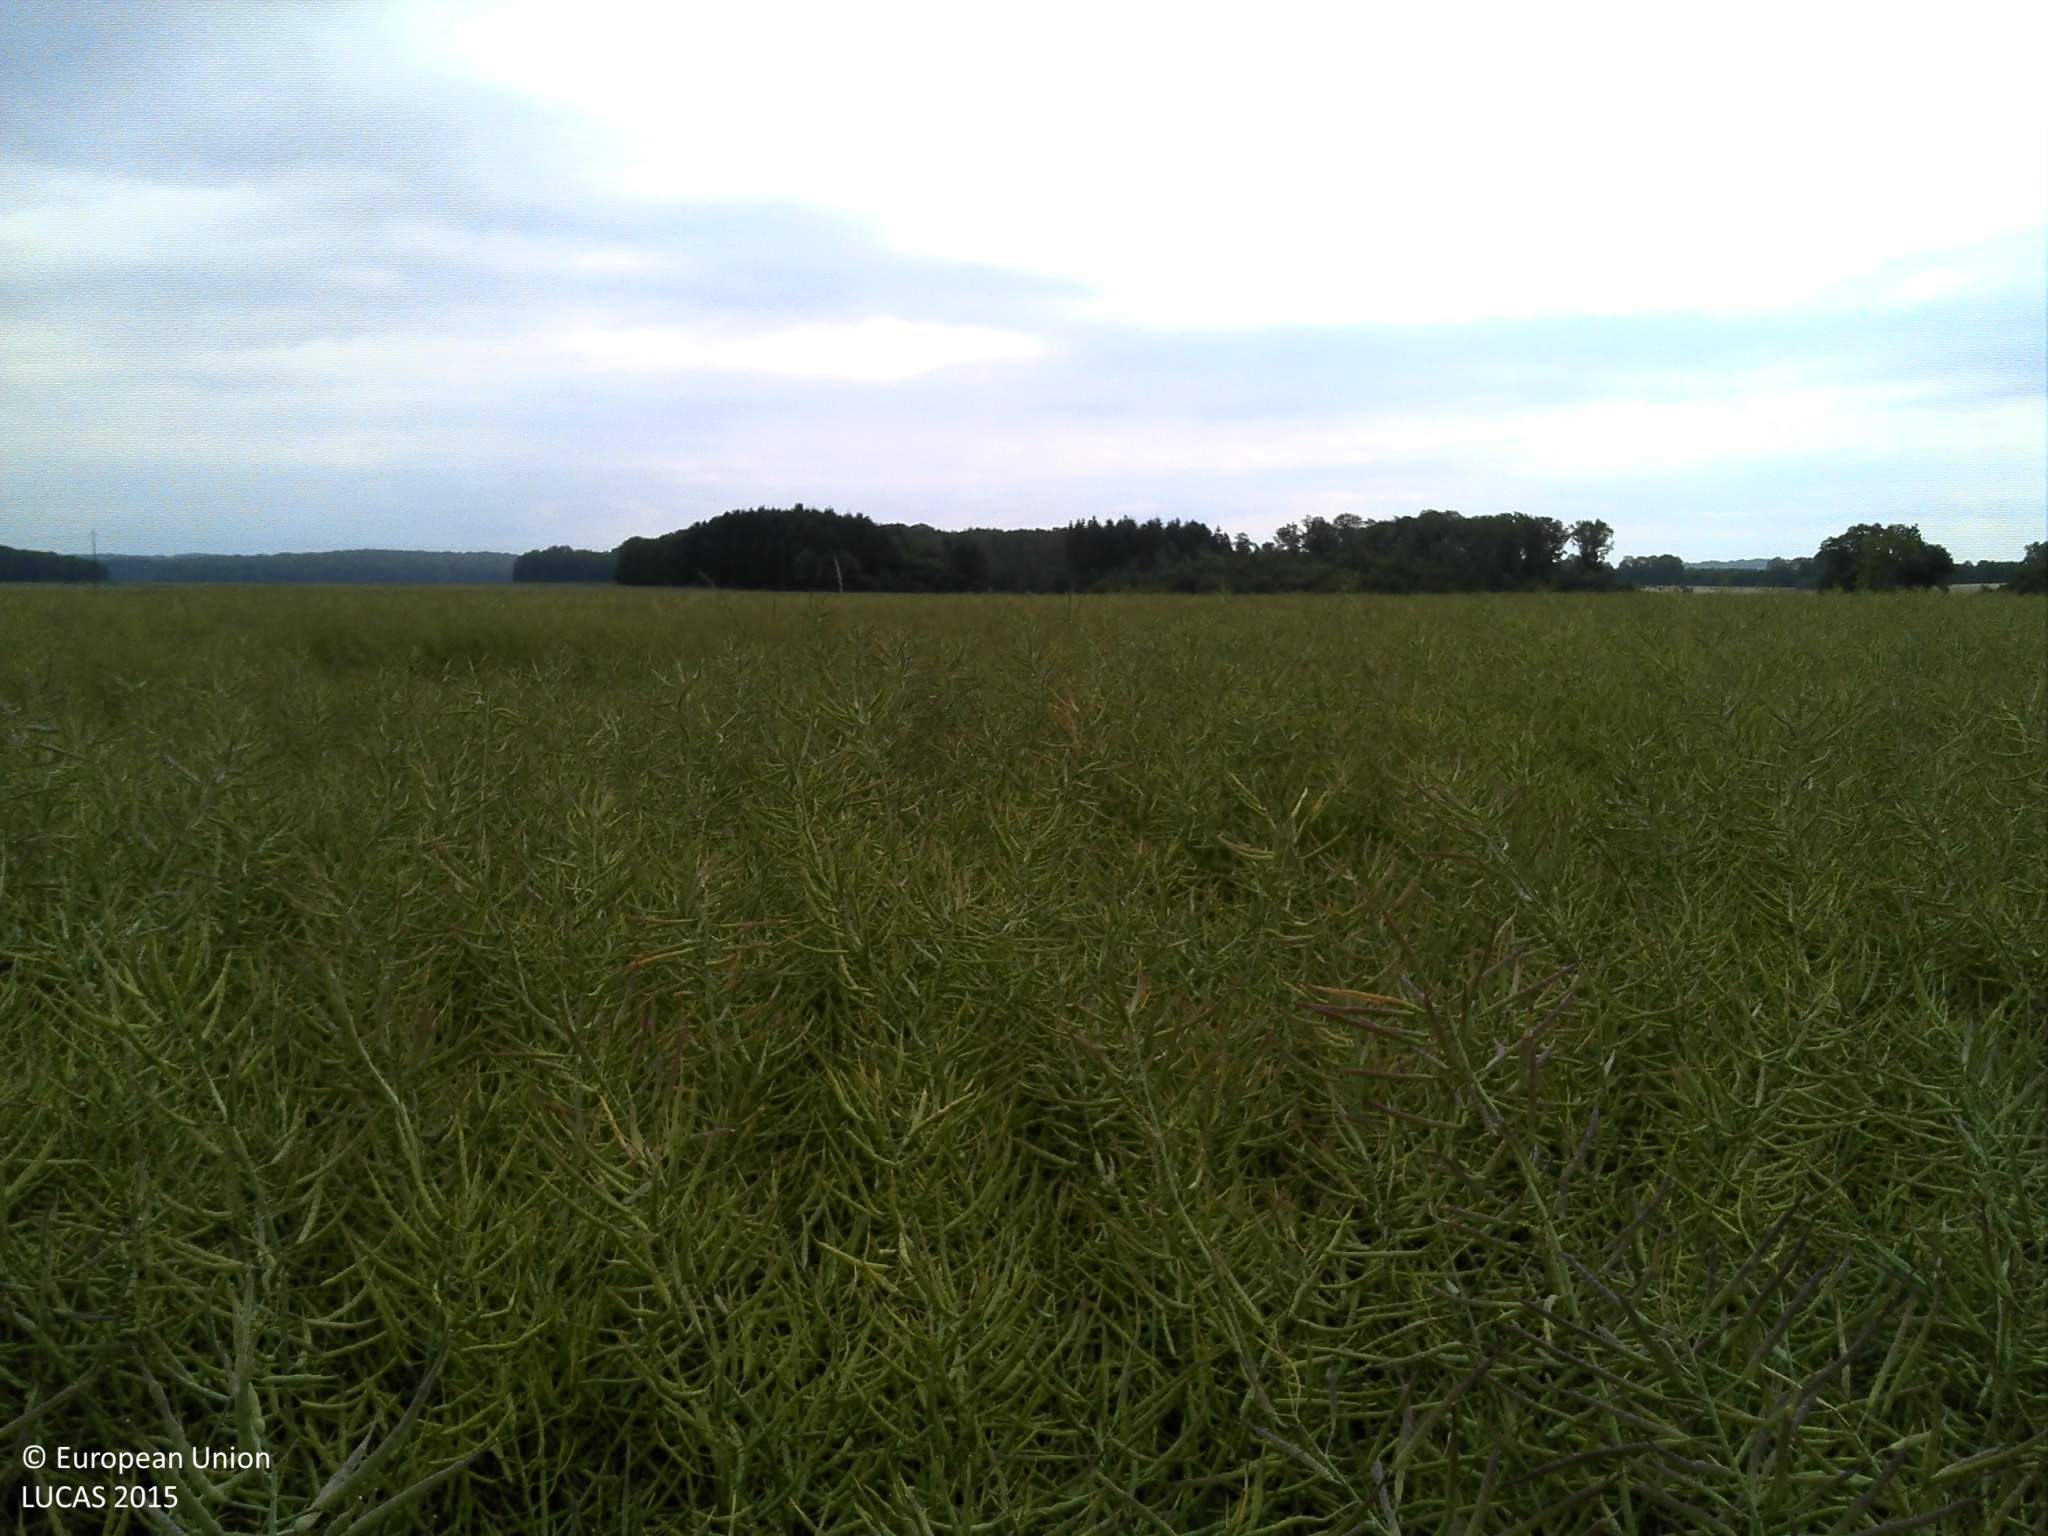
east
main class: Cropland
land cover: Rape and turnip rape
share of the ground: > 75 %
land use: Agriculture (excluding fallow land and kitchen gardens)
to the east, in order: Rape and turnip rape; Grass margins; Ditches and canals; Paved roads, cycling and walking lanes; Grass margins; Common wheat; Maize
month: June
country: FR
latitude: 49.3730
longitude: 5.0259
